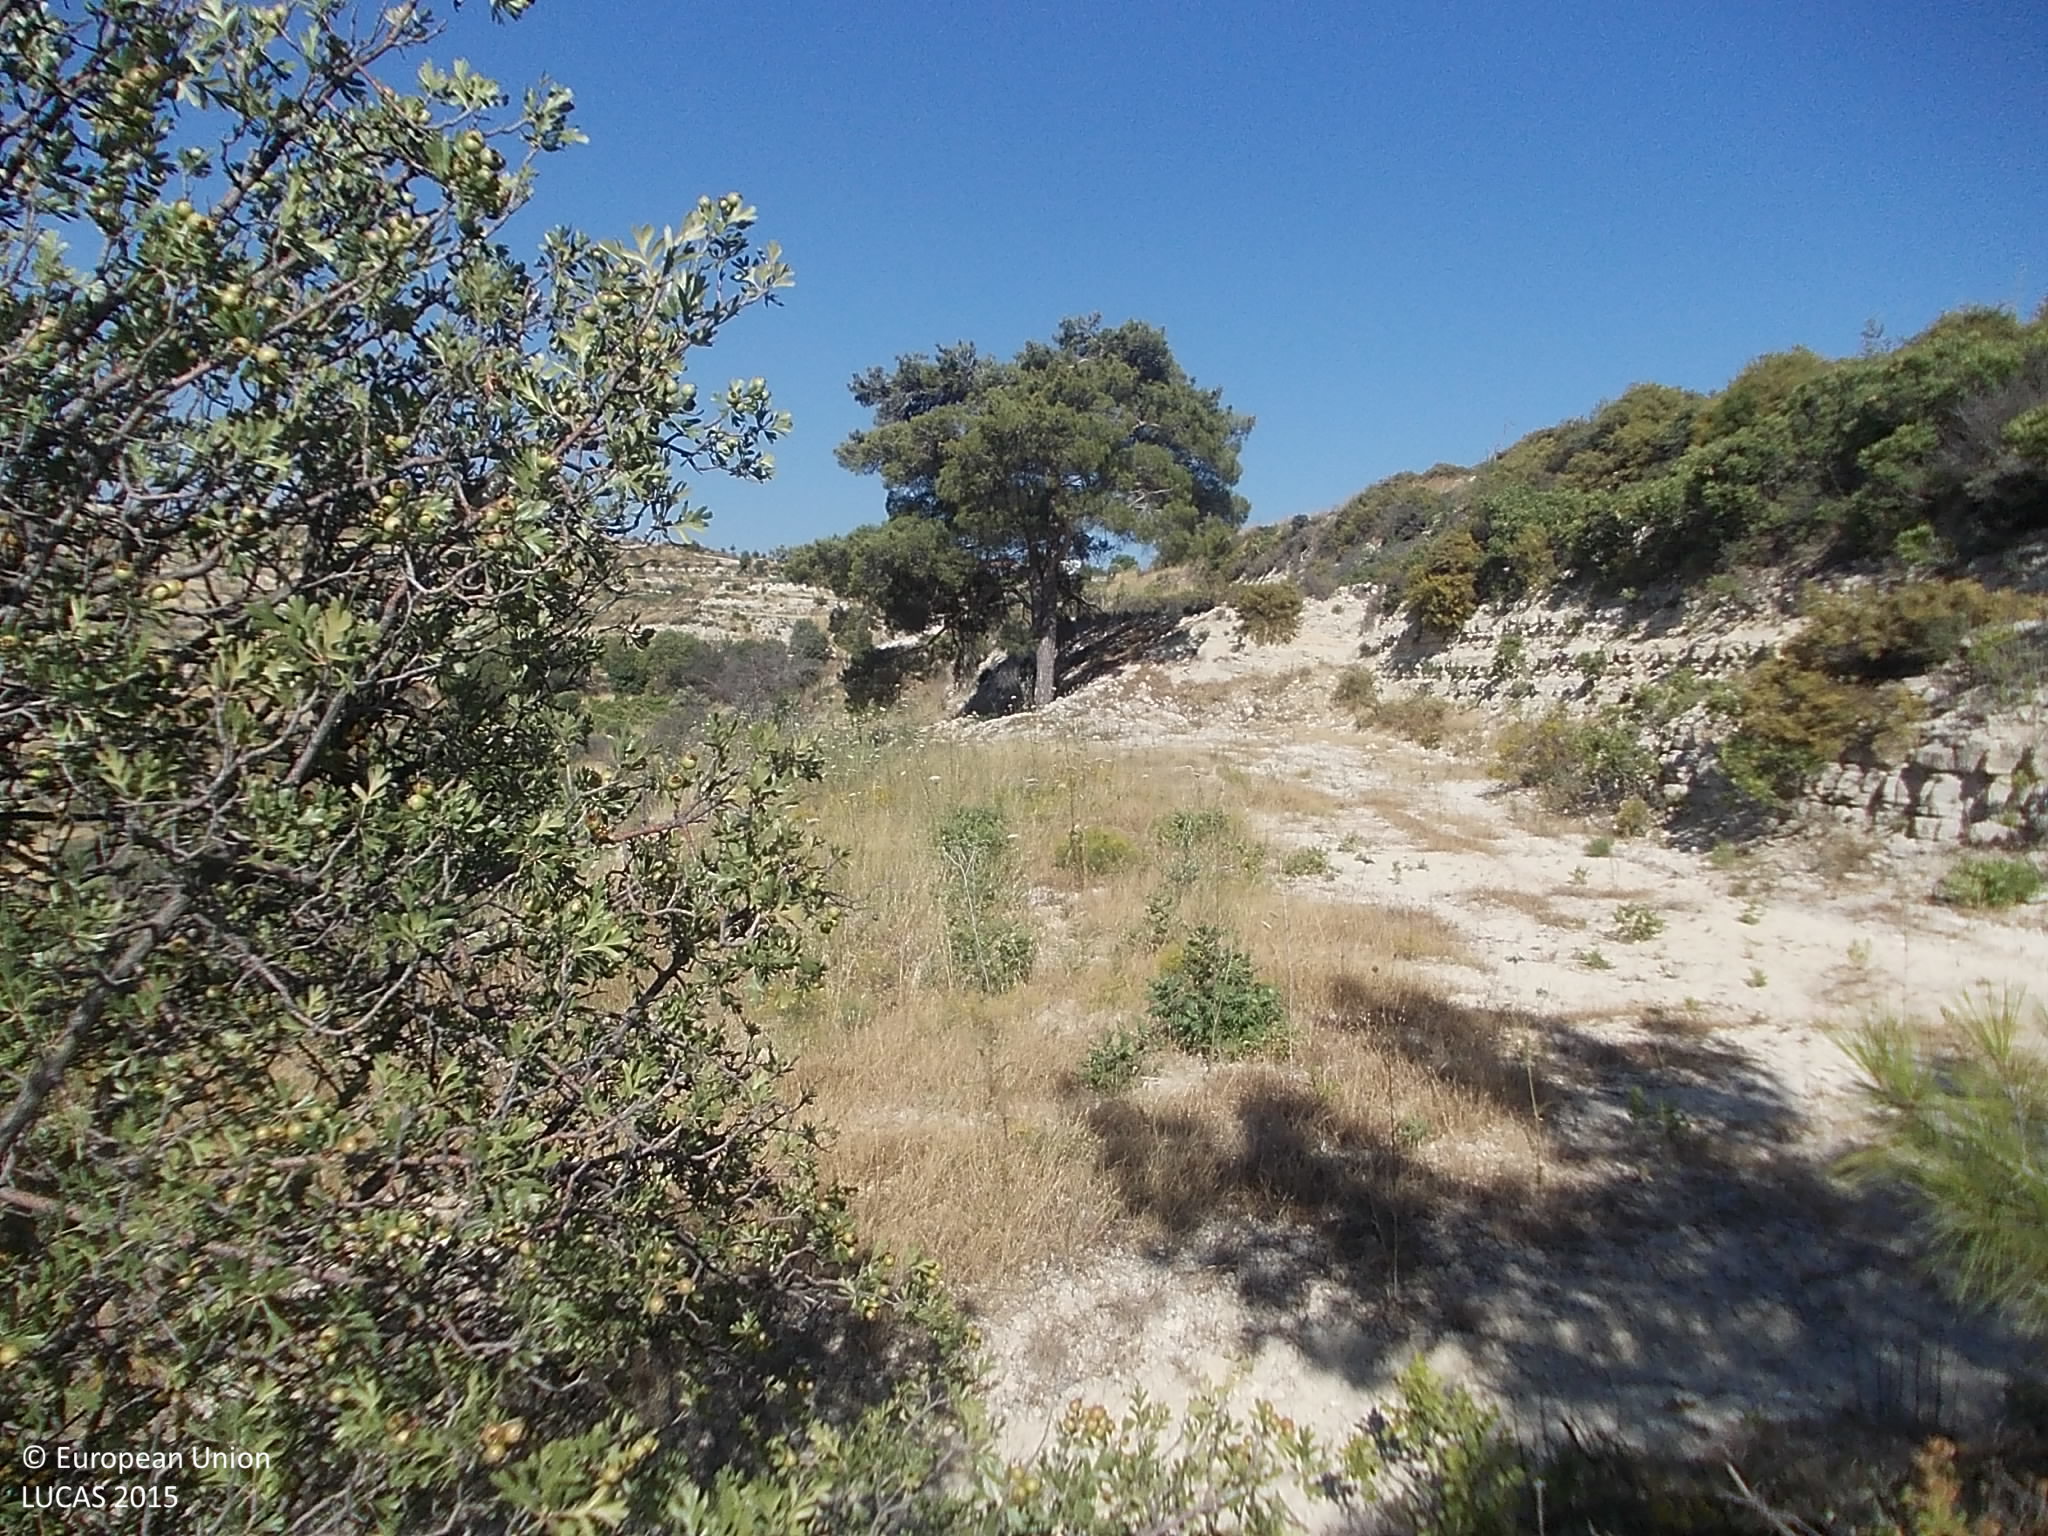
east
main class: Shrubland
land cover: Shrubland with sparse tree cover
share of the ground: 50 - 75 %
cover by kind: shrubs 55 %, herbaceous plants 25 %, unconsolidated bare surface 15 %, coniferous forest trees 5 %
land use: Semi-natural and natural areas not in use
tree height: < 5 m
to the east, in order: Shrubland with sparse tree cover; Grassland without tree/shrub cover; Grassland with sparse tree/shrub cover; Vineyards; Dry stone walls; Fences; Grassland with sparse tree/shrub cover
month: July
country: CY
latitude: 34.8198
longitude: 32.8249
